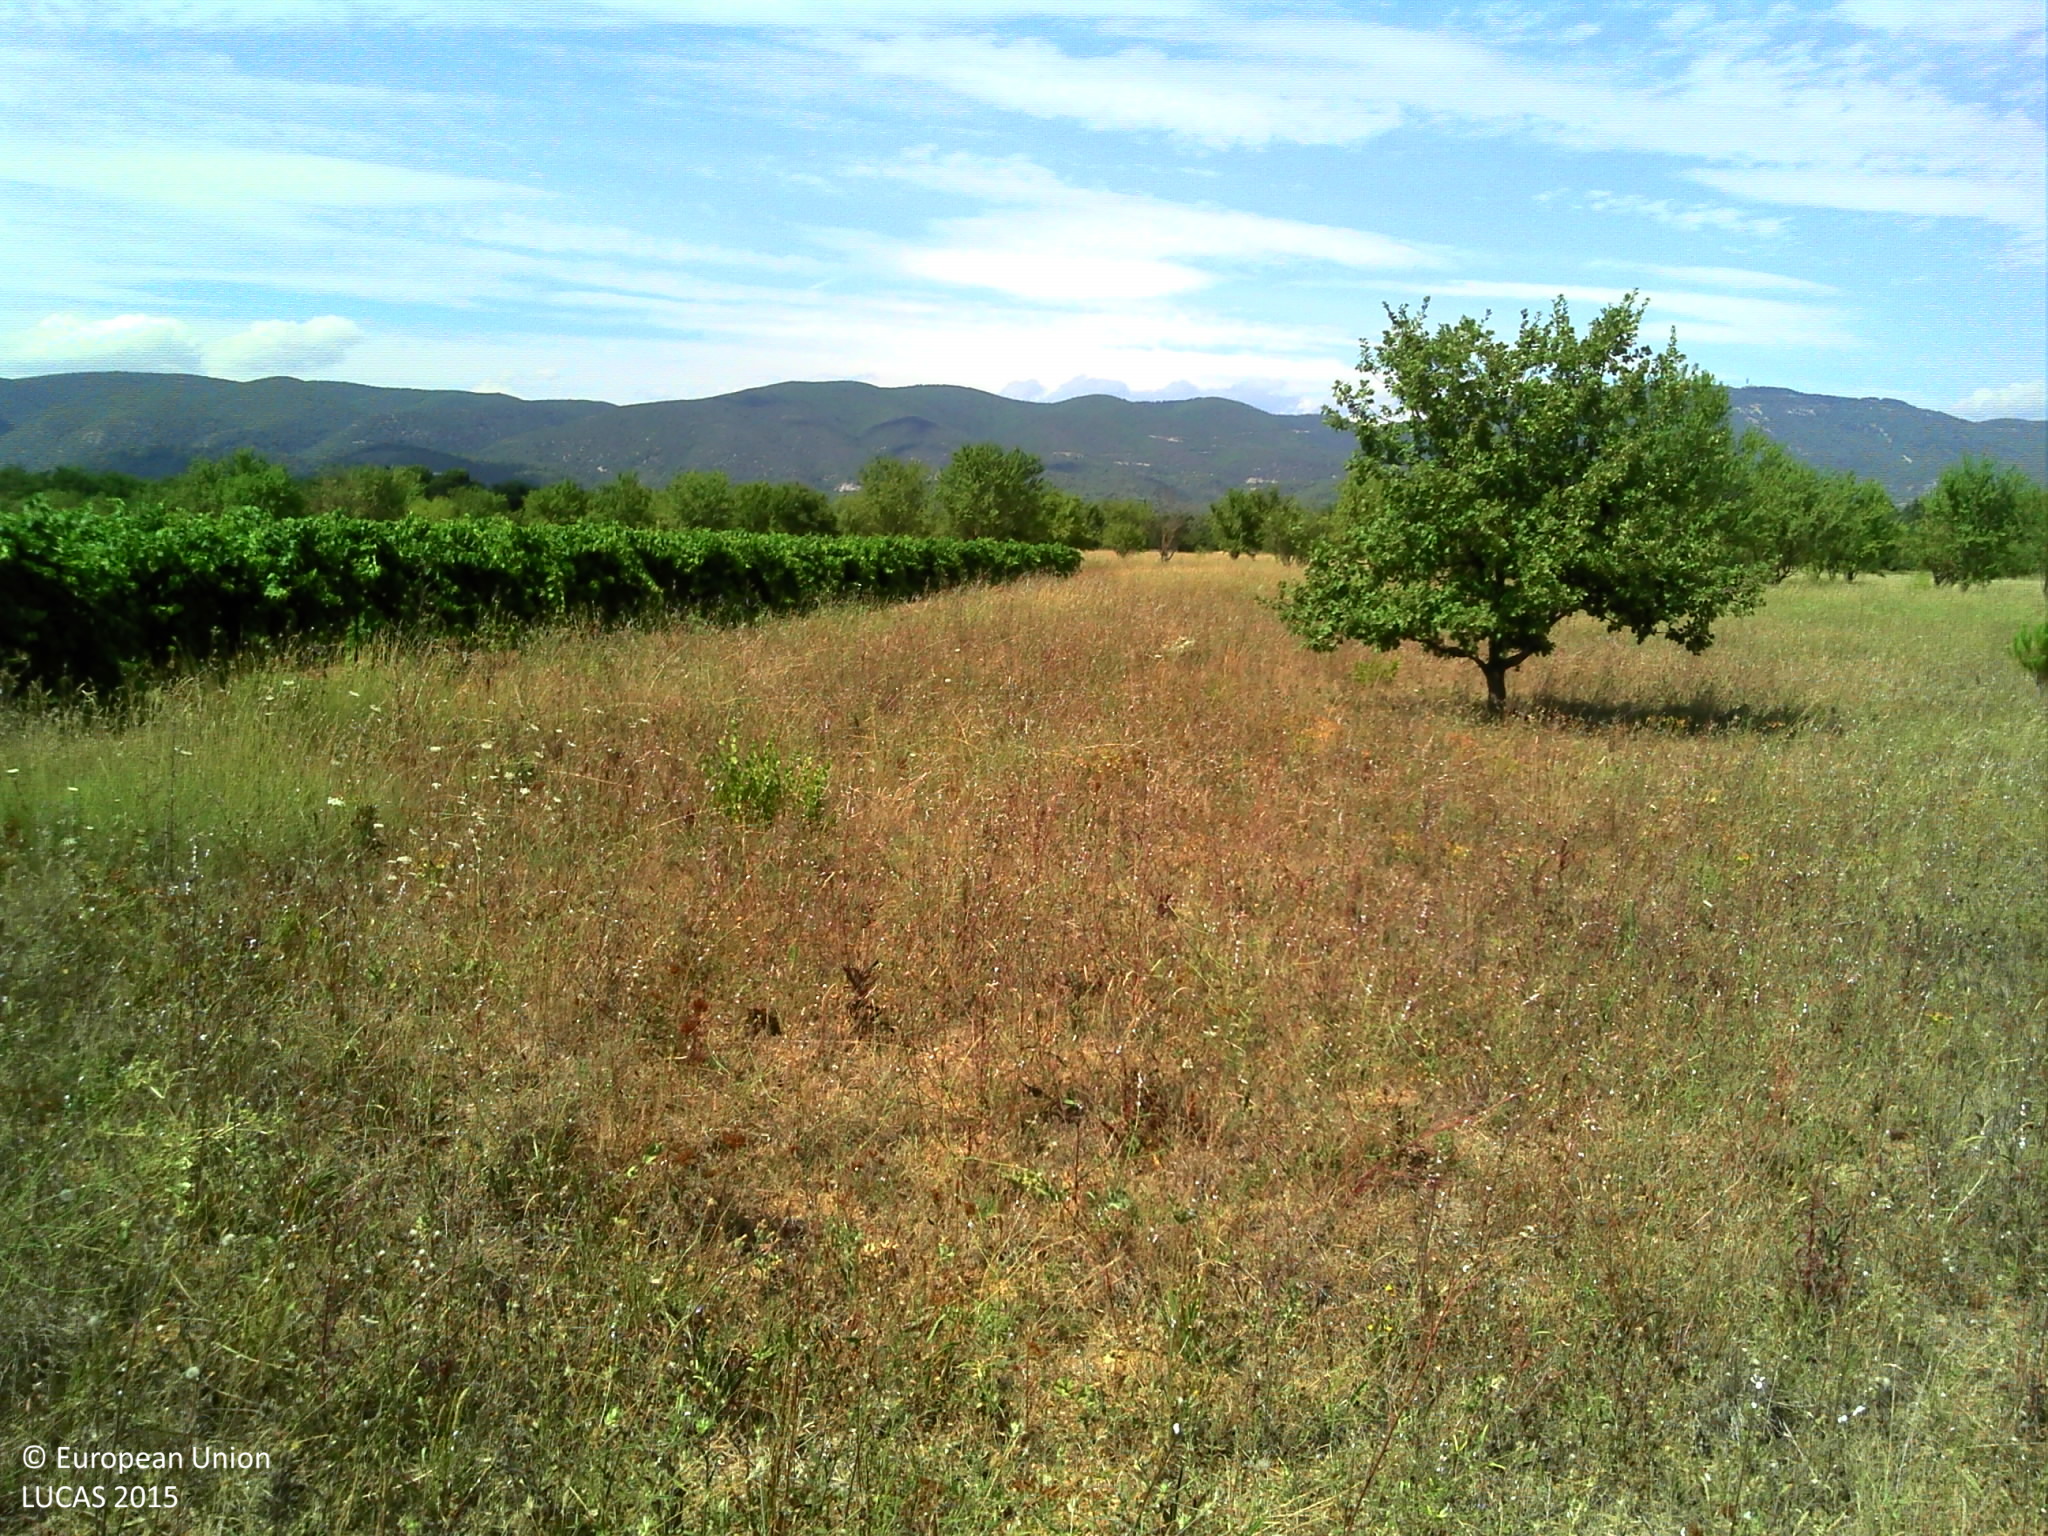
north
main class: Grassland
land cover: Grassland without tree/shrub cover
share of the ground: > 75 %
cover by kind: herbaceous plants 85 %, unconsolidated bare surface 15 %
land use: Semi-natural and natural areas not in use
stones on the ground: < 10 %
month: July
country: FR
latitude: 43.7439
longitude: 5.4270
